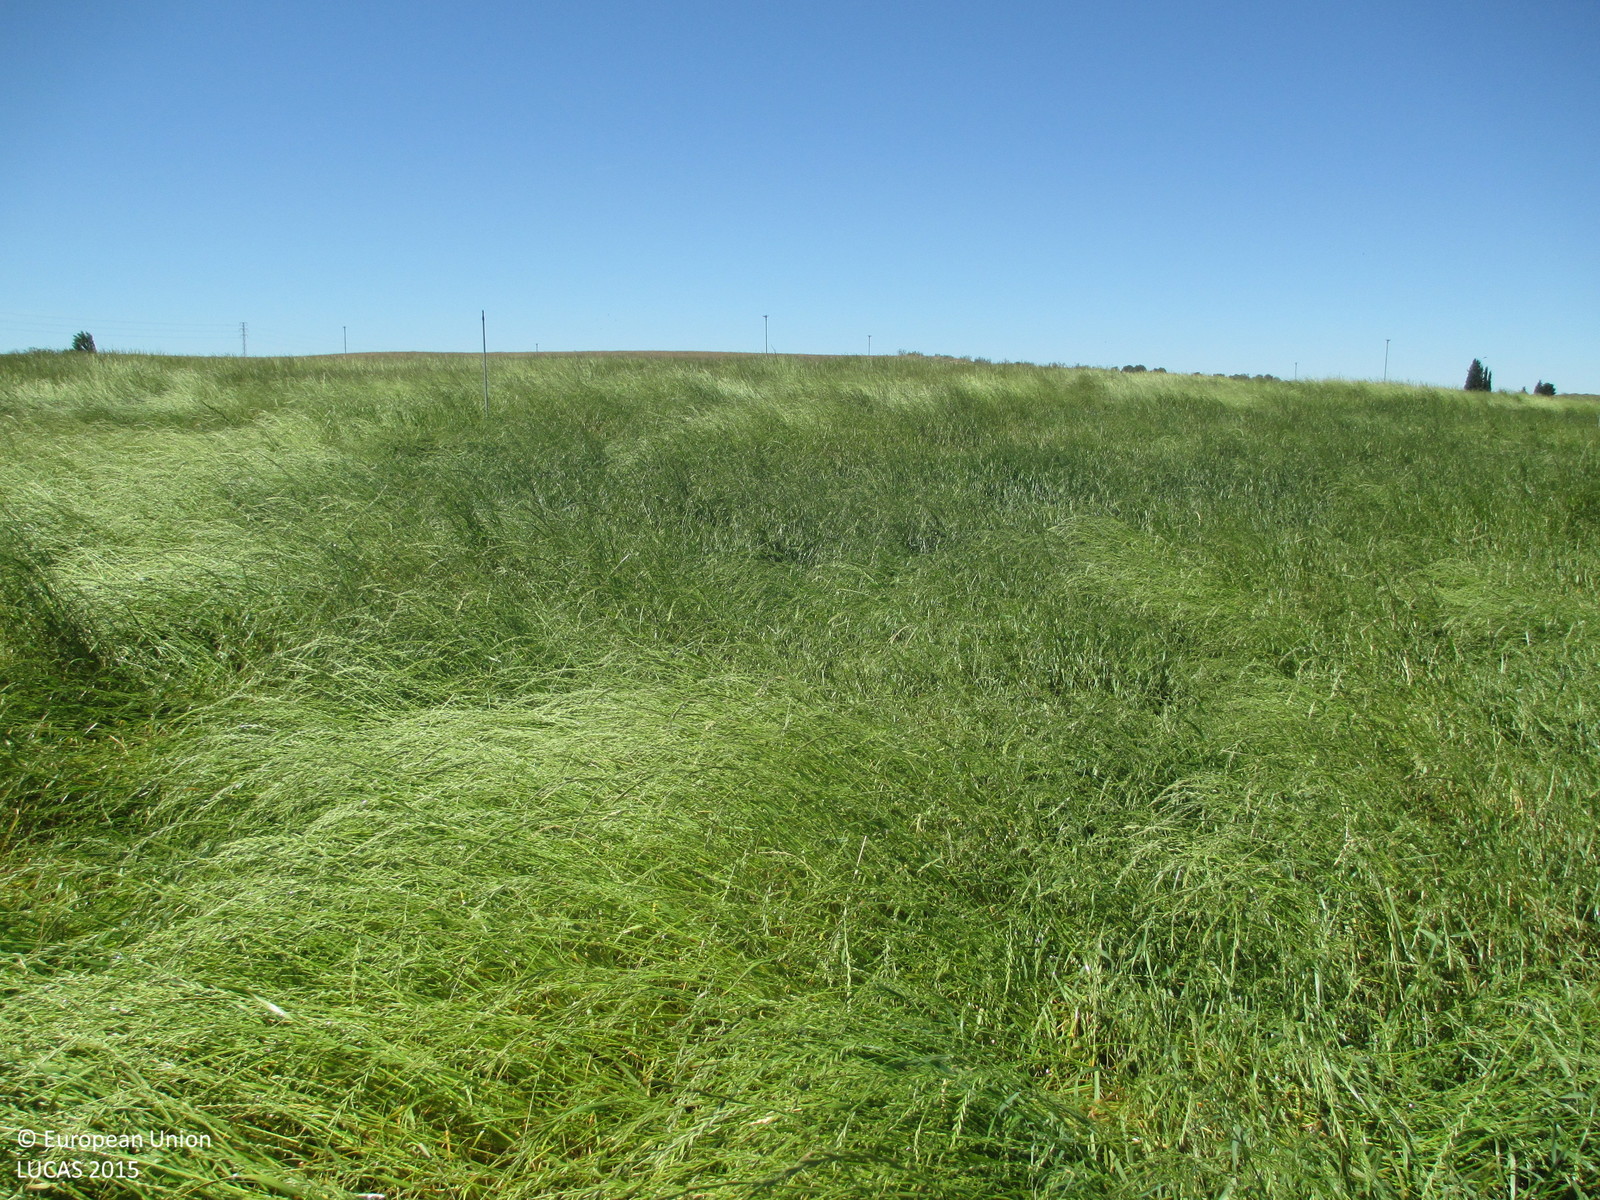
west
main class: Cropland
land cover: Temporary grasslands
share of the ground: > 75 %
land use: Agriculture (excluding fallow land and kitchen gardens)
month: May
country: ES
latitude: 41.8780
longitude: -0.2496
